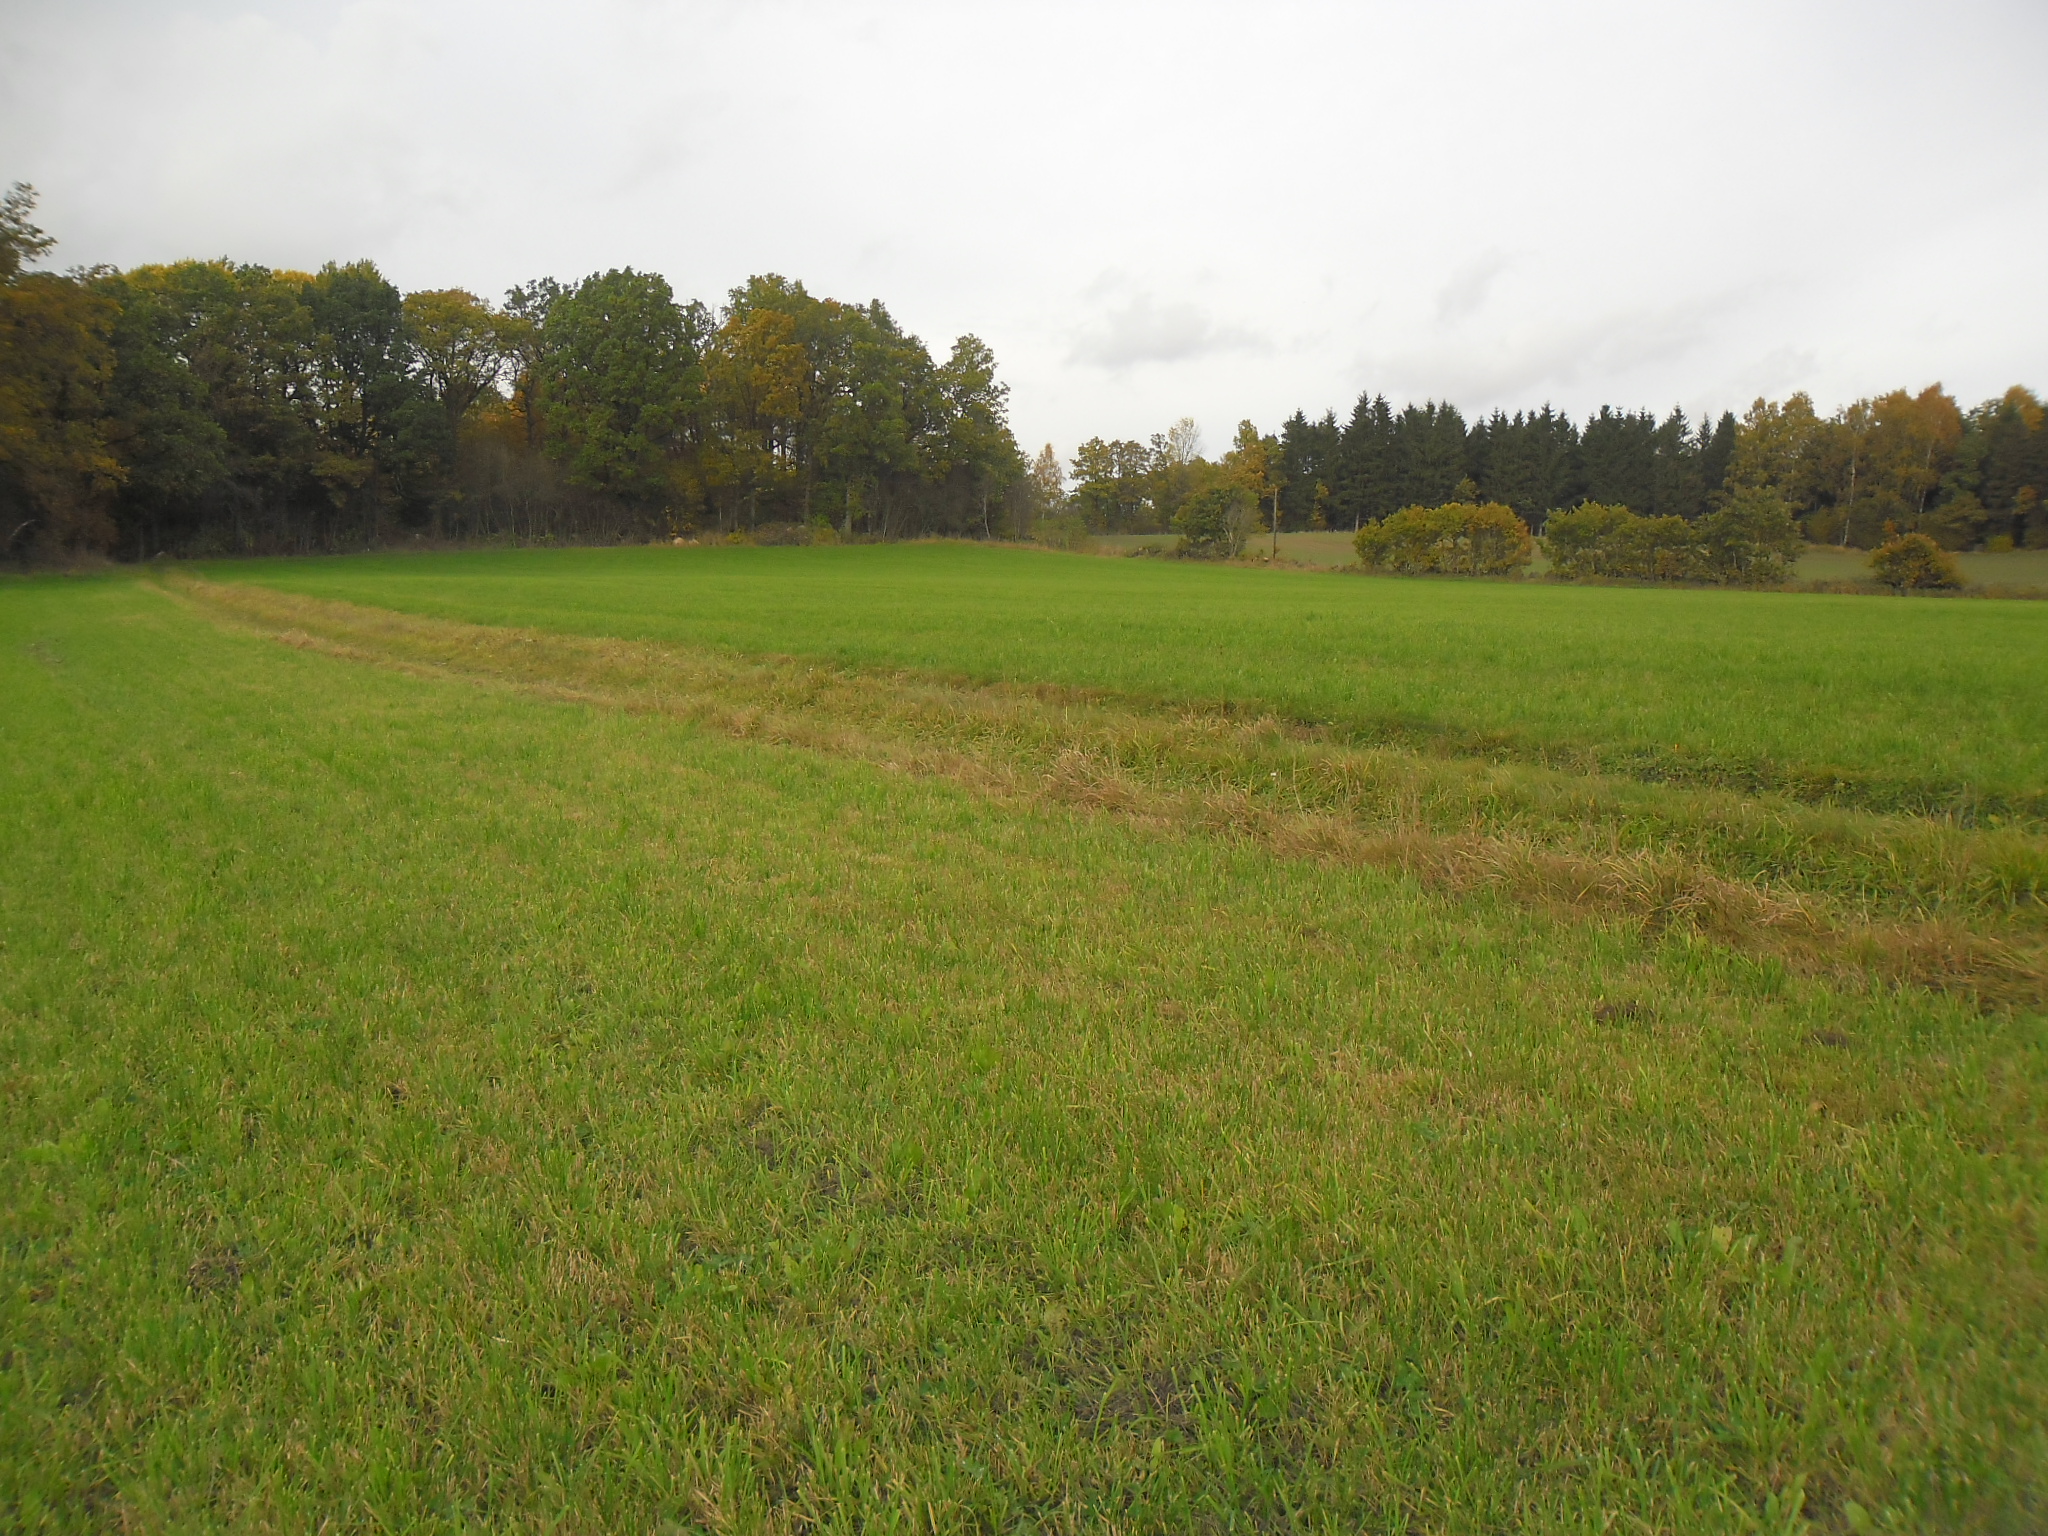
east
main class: Grassland
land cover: Grassland without tree/shrub cover
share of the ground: > 75 %
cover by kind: herbaceous plants 100 %
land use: Agriculture (excluding fallow land and kitchen gardens)
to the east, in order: Grassland without tree/shrub cover; Tracks; Grassland without tree/shrub cover; Electric lines; Grass margins; Paved roads, cycling and walking lanes; Grass margins; Broadleaved woodland; Grassland without tree/shrub cover; Tracks; Grass margins; Common wheat
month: October
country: SE
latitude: 56.0443
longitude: 13.7059
